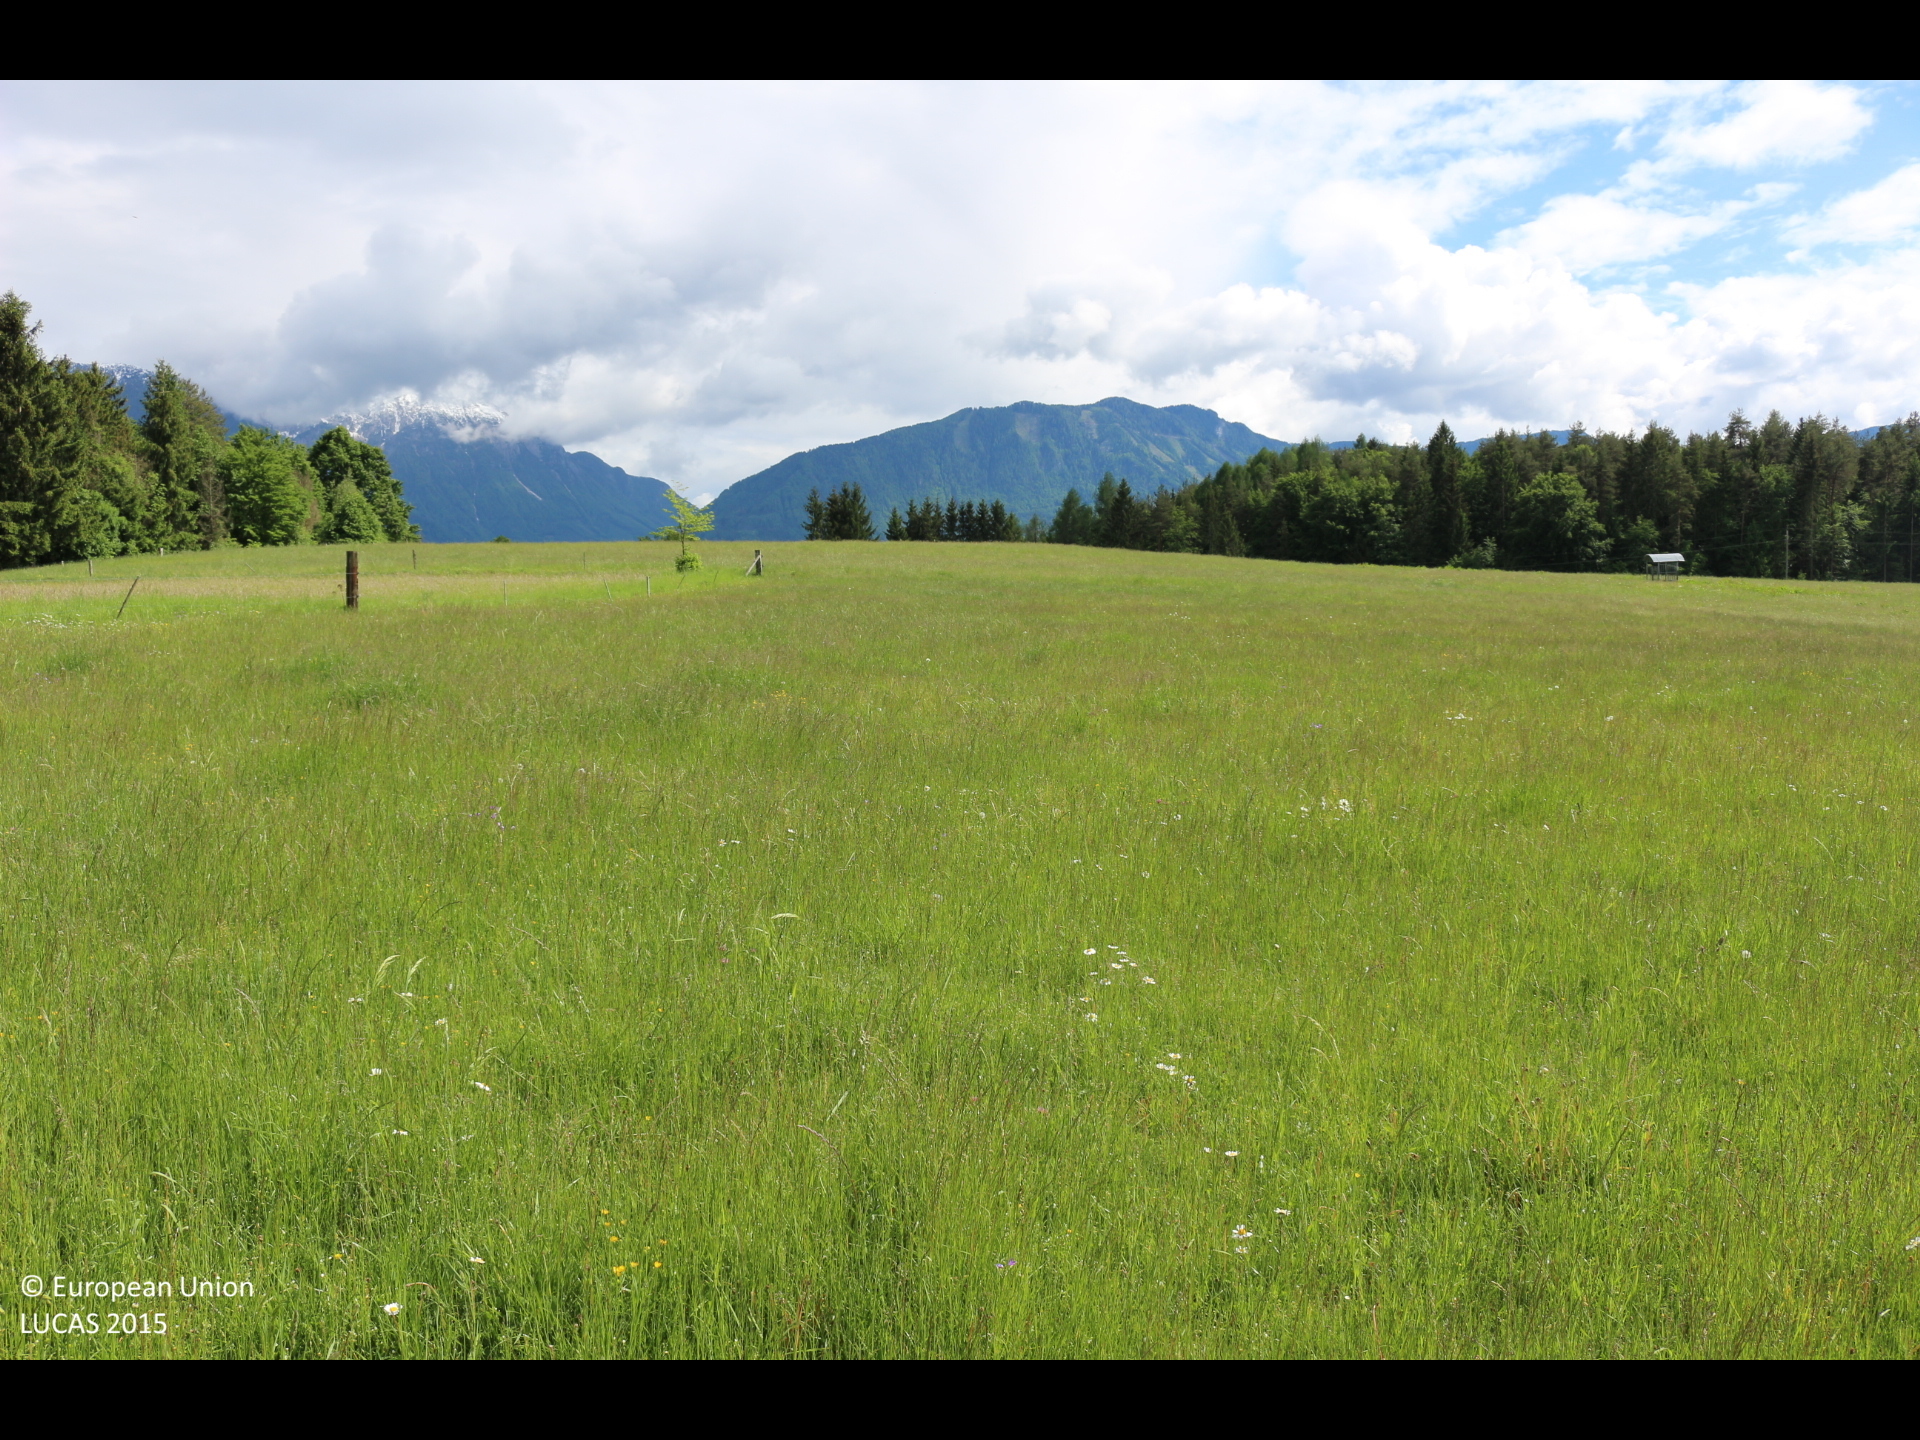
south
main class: Grassland
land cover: Grassland without tree/shrub cover
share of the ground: > 75 %
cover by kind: herbaceous plants 100 %
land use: Agriculture (excluding fallow land and kitchen gardens)
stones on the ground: < 10 %
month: May
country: AT
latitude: 46.5845
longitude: 14.4216
